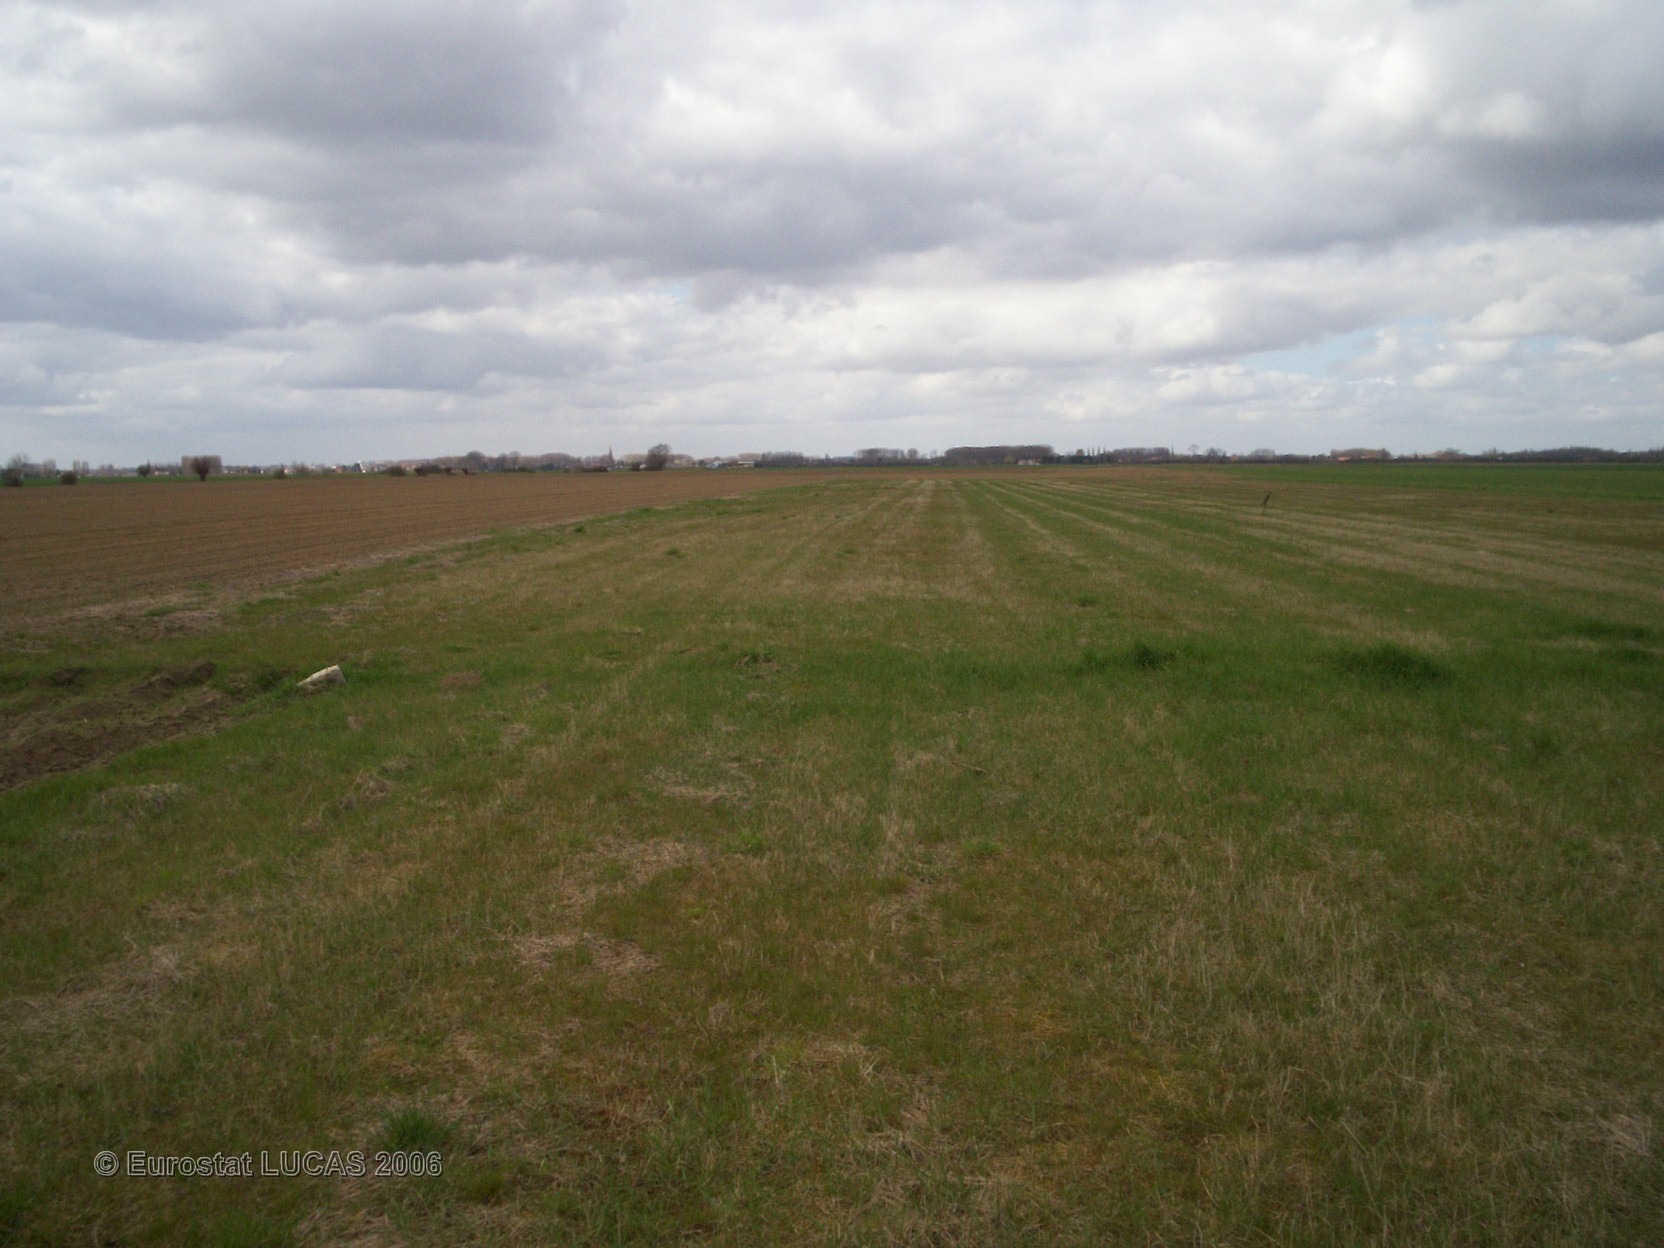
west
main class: Grassland
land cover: Grassland without tree/shrub cover
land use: Agriculture (excluding fallow land and kitchen gardens)
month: April
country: FR
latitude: 50.6116
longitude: 2.5970
